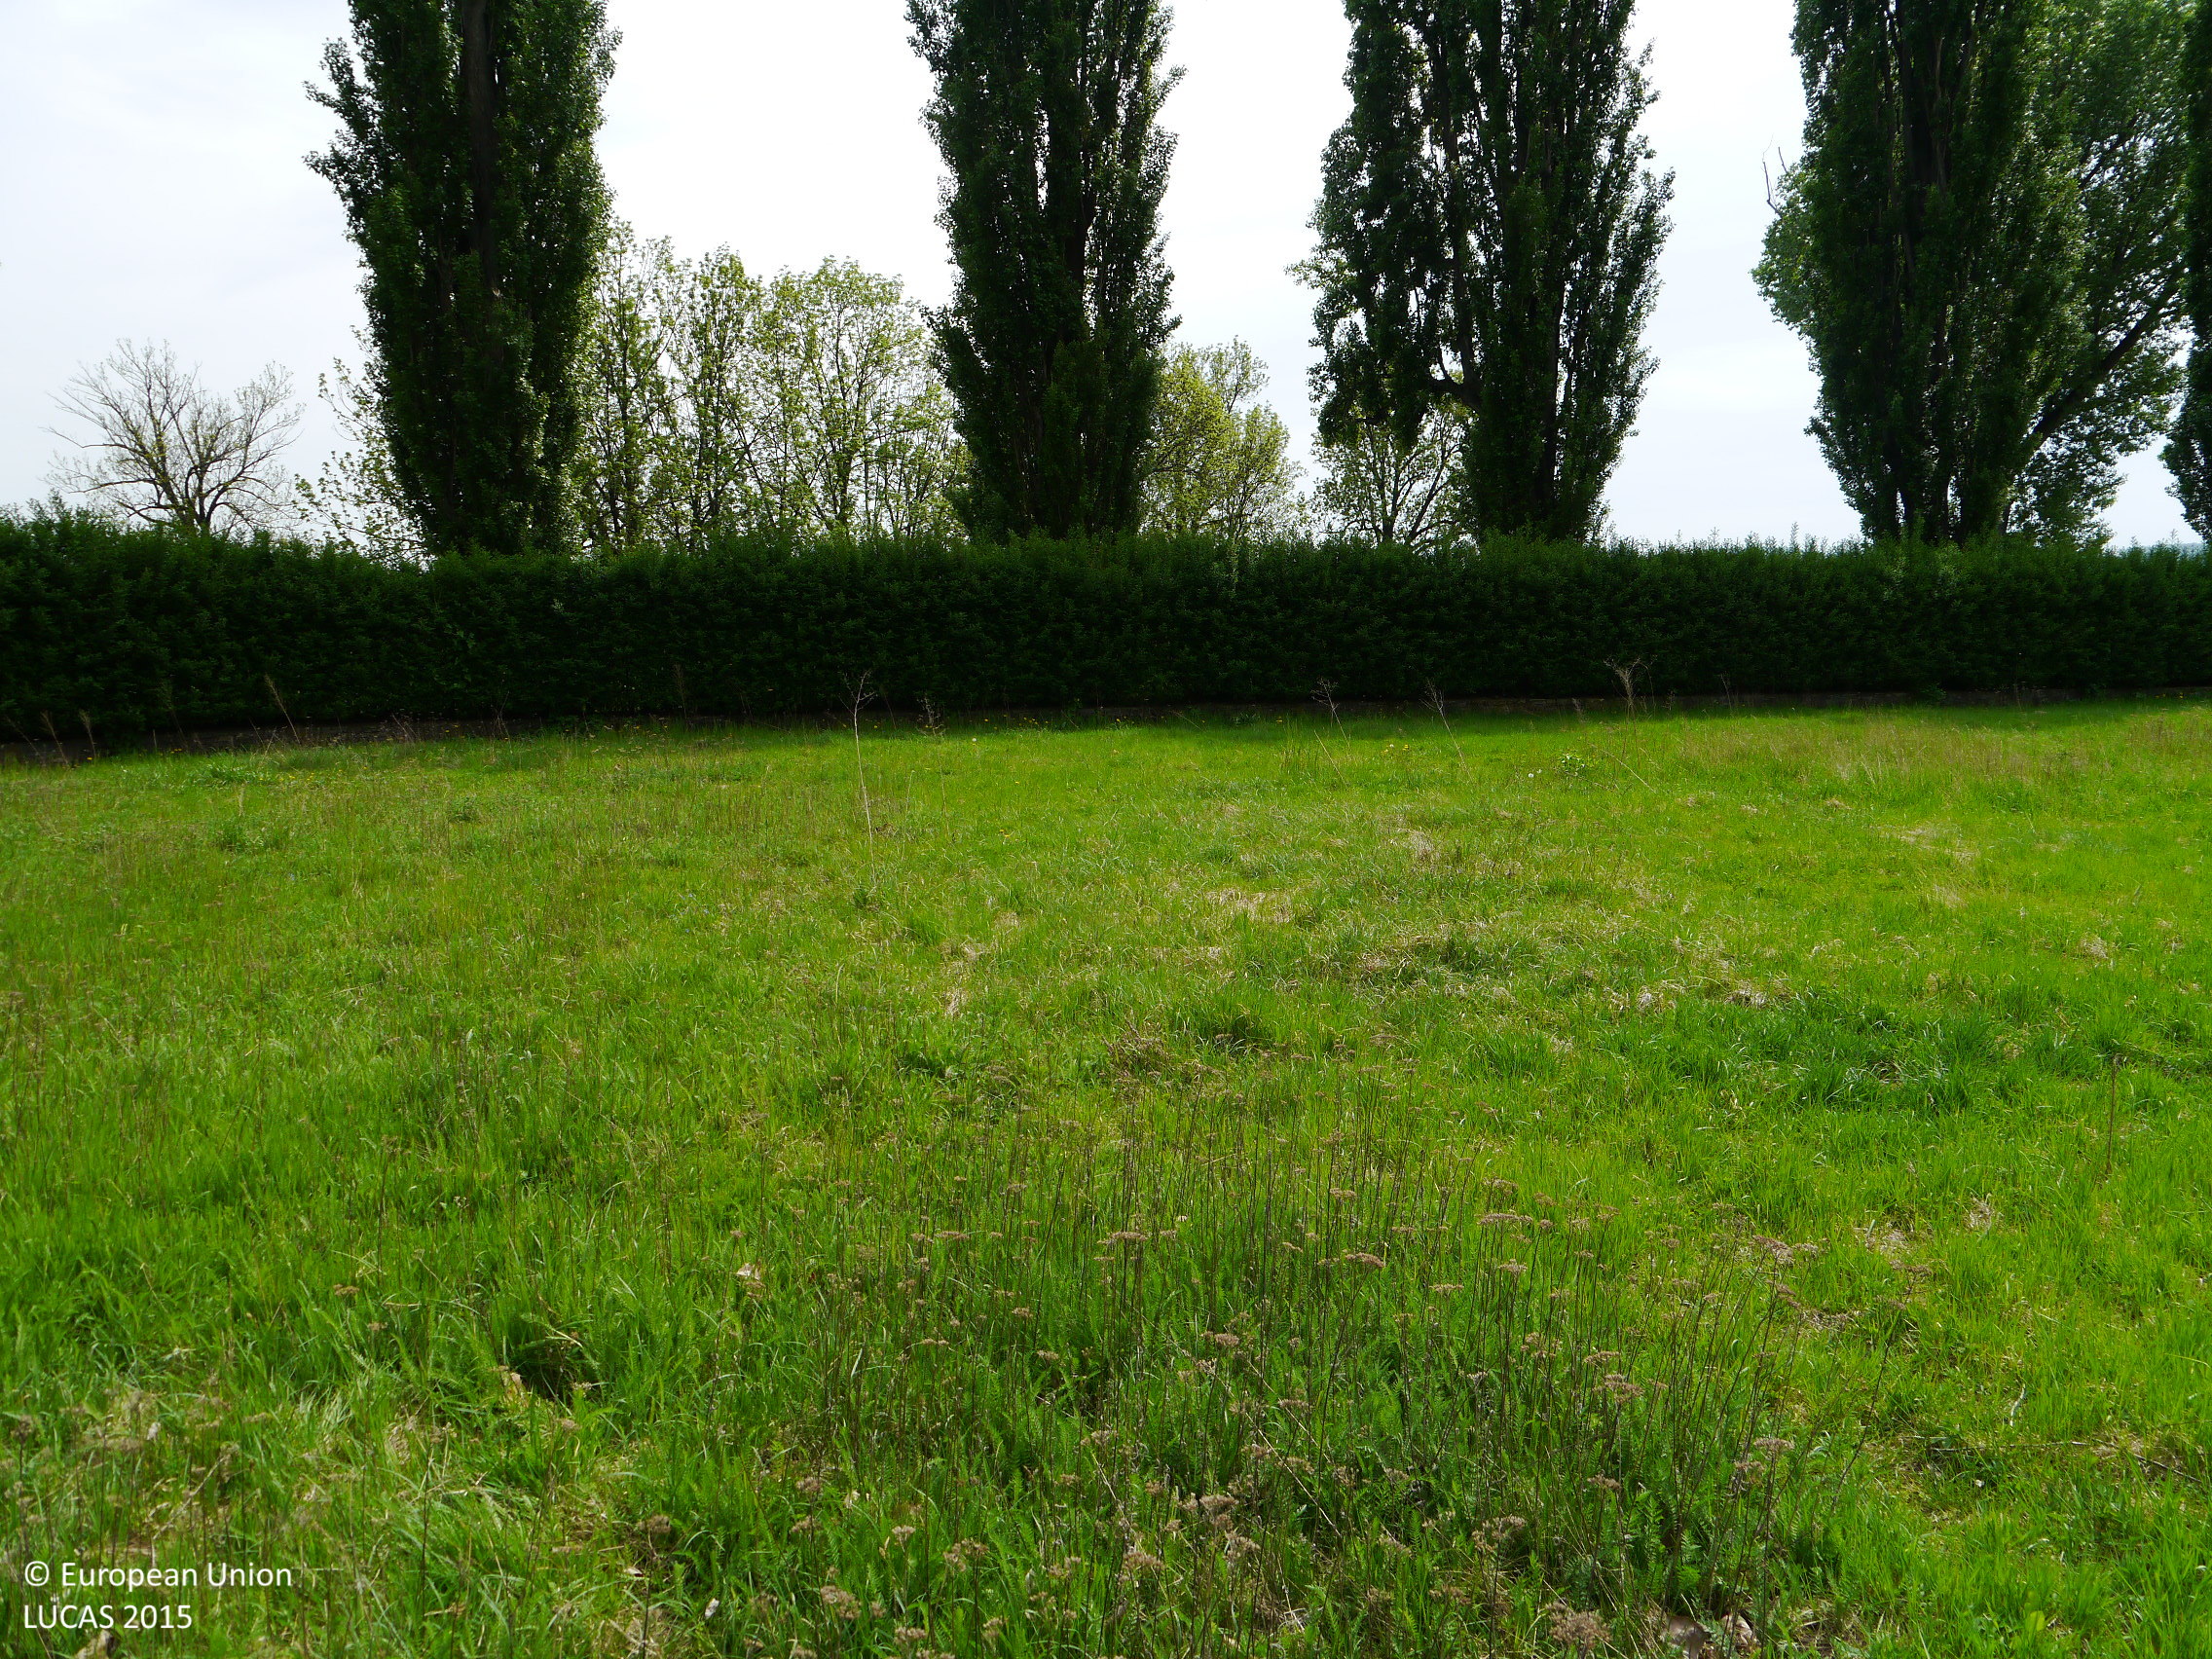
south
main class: Grassland
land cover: Grassland without tree/shrub cover
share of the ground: > 75 %
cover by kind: herbaceous plants 100 %
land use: Sport
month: May
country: AT
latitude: 47.0625
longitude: 15.4112
